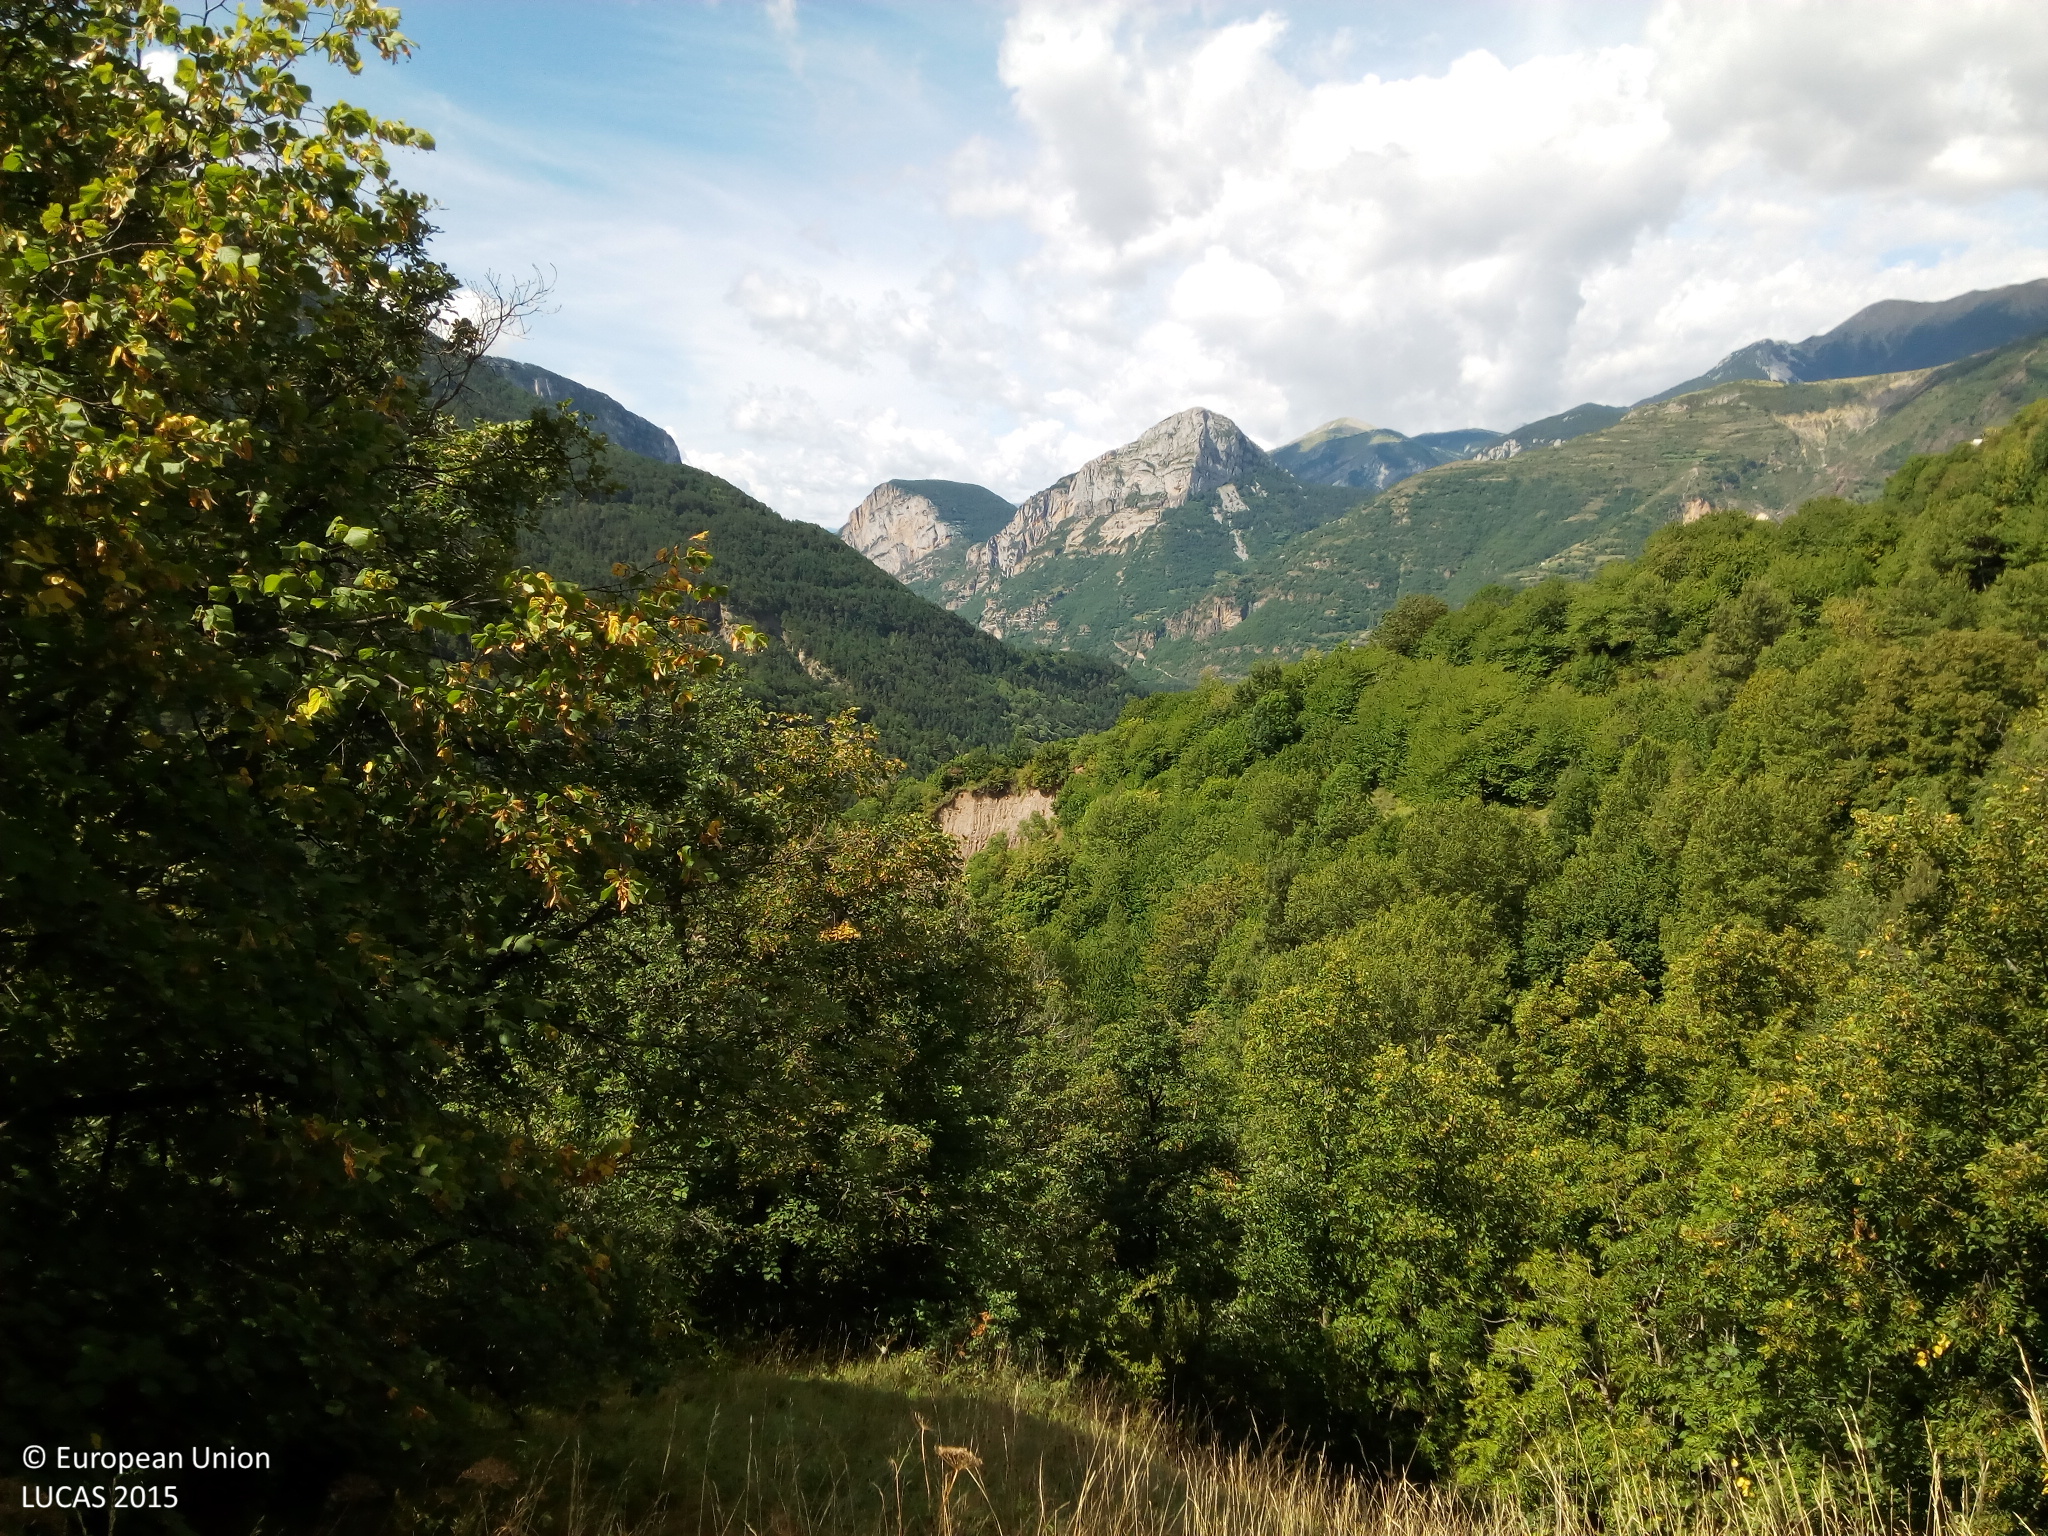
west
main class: Woodland
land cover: Broadleaved woodland
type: floodplain forest
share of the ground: > 75 %
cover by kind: broadleaved forest trees 80 %, herbaceous plants 15 %, shrubs 5 %
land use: Semi-natural and natural areas not in use
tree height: > 5 m
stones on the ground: < 10 %
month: September
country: ES
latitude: 42.5755
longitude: 0.3665
